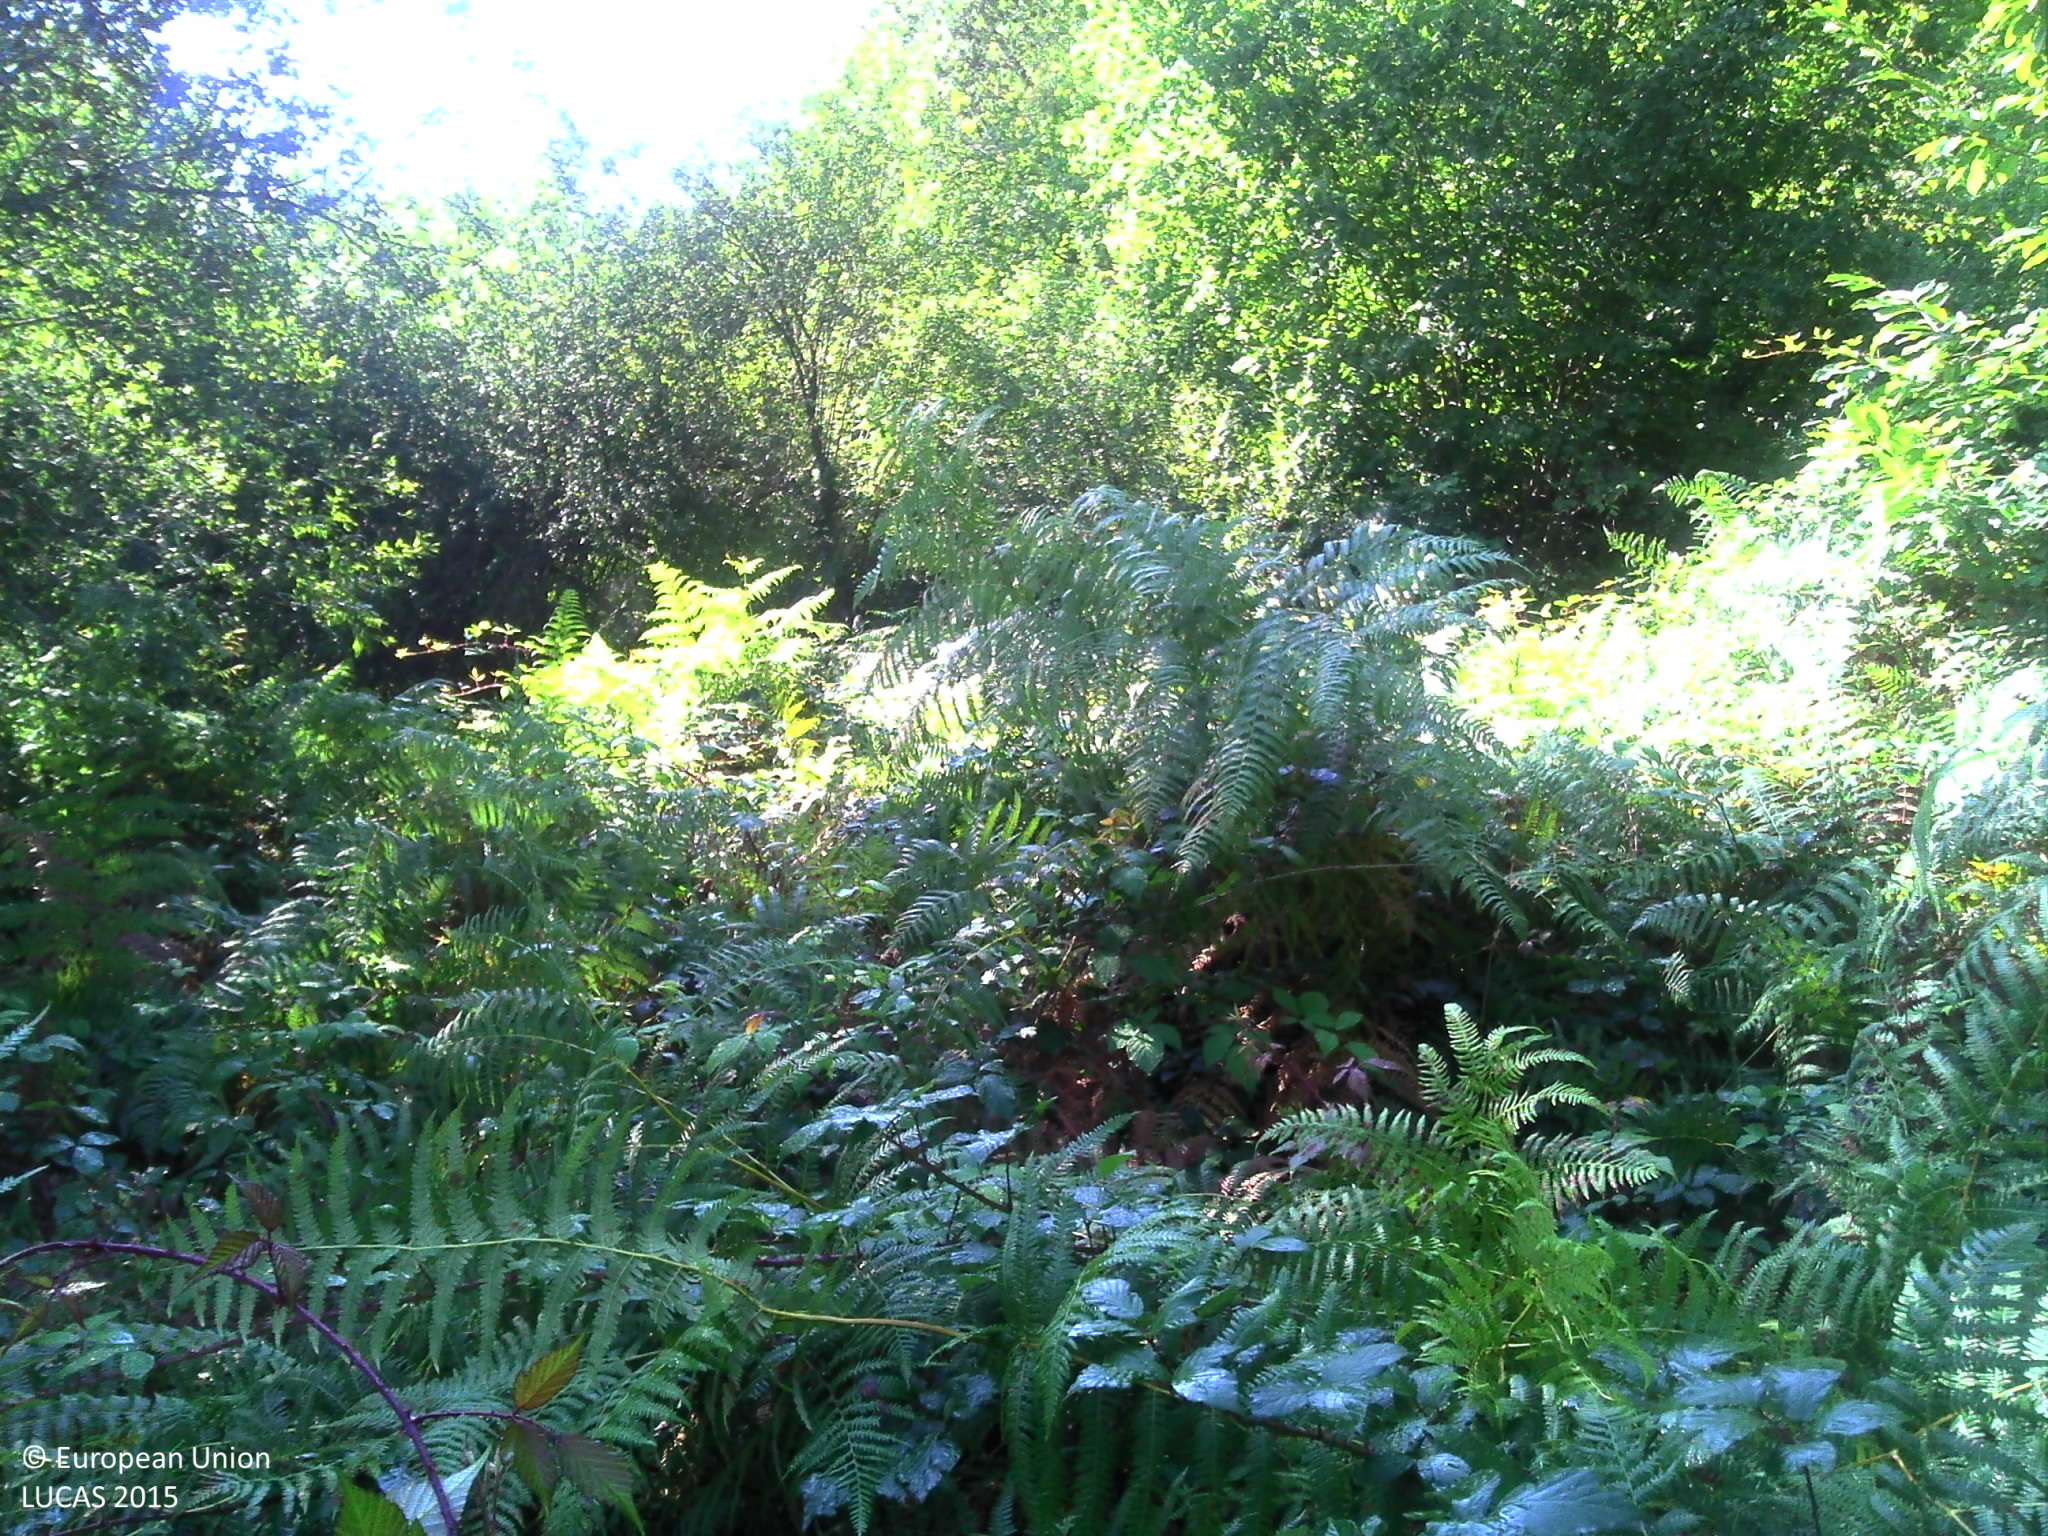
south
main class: Shrubland
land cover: Shrubland with sparse tree cover
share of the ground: > 75 %
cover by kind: shrubs 55 %, herbaceous plants 40 %, broadleaved forest trees 5 %
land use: Semi-natural and natural areas not in use
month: September
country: FR
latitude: 43.1033
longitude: -0.8839
